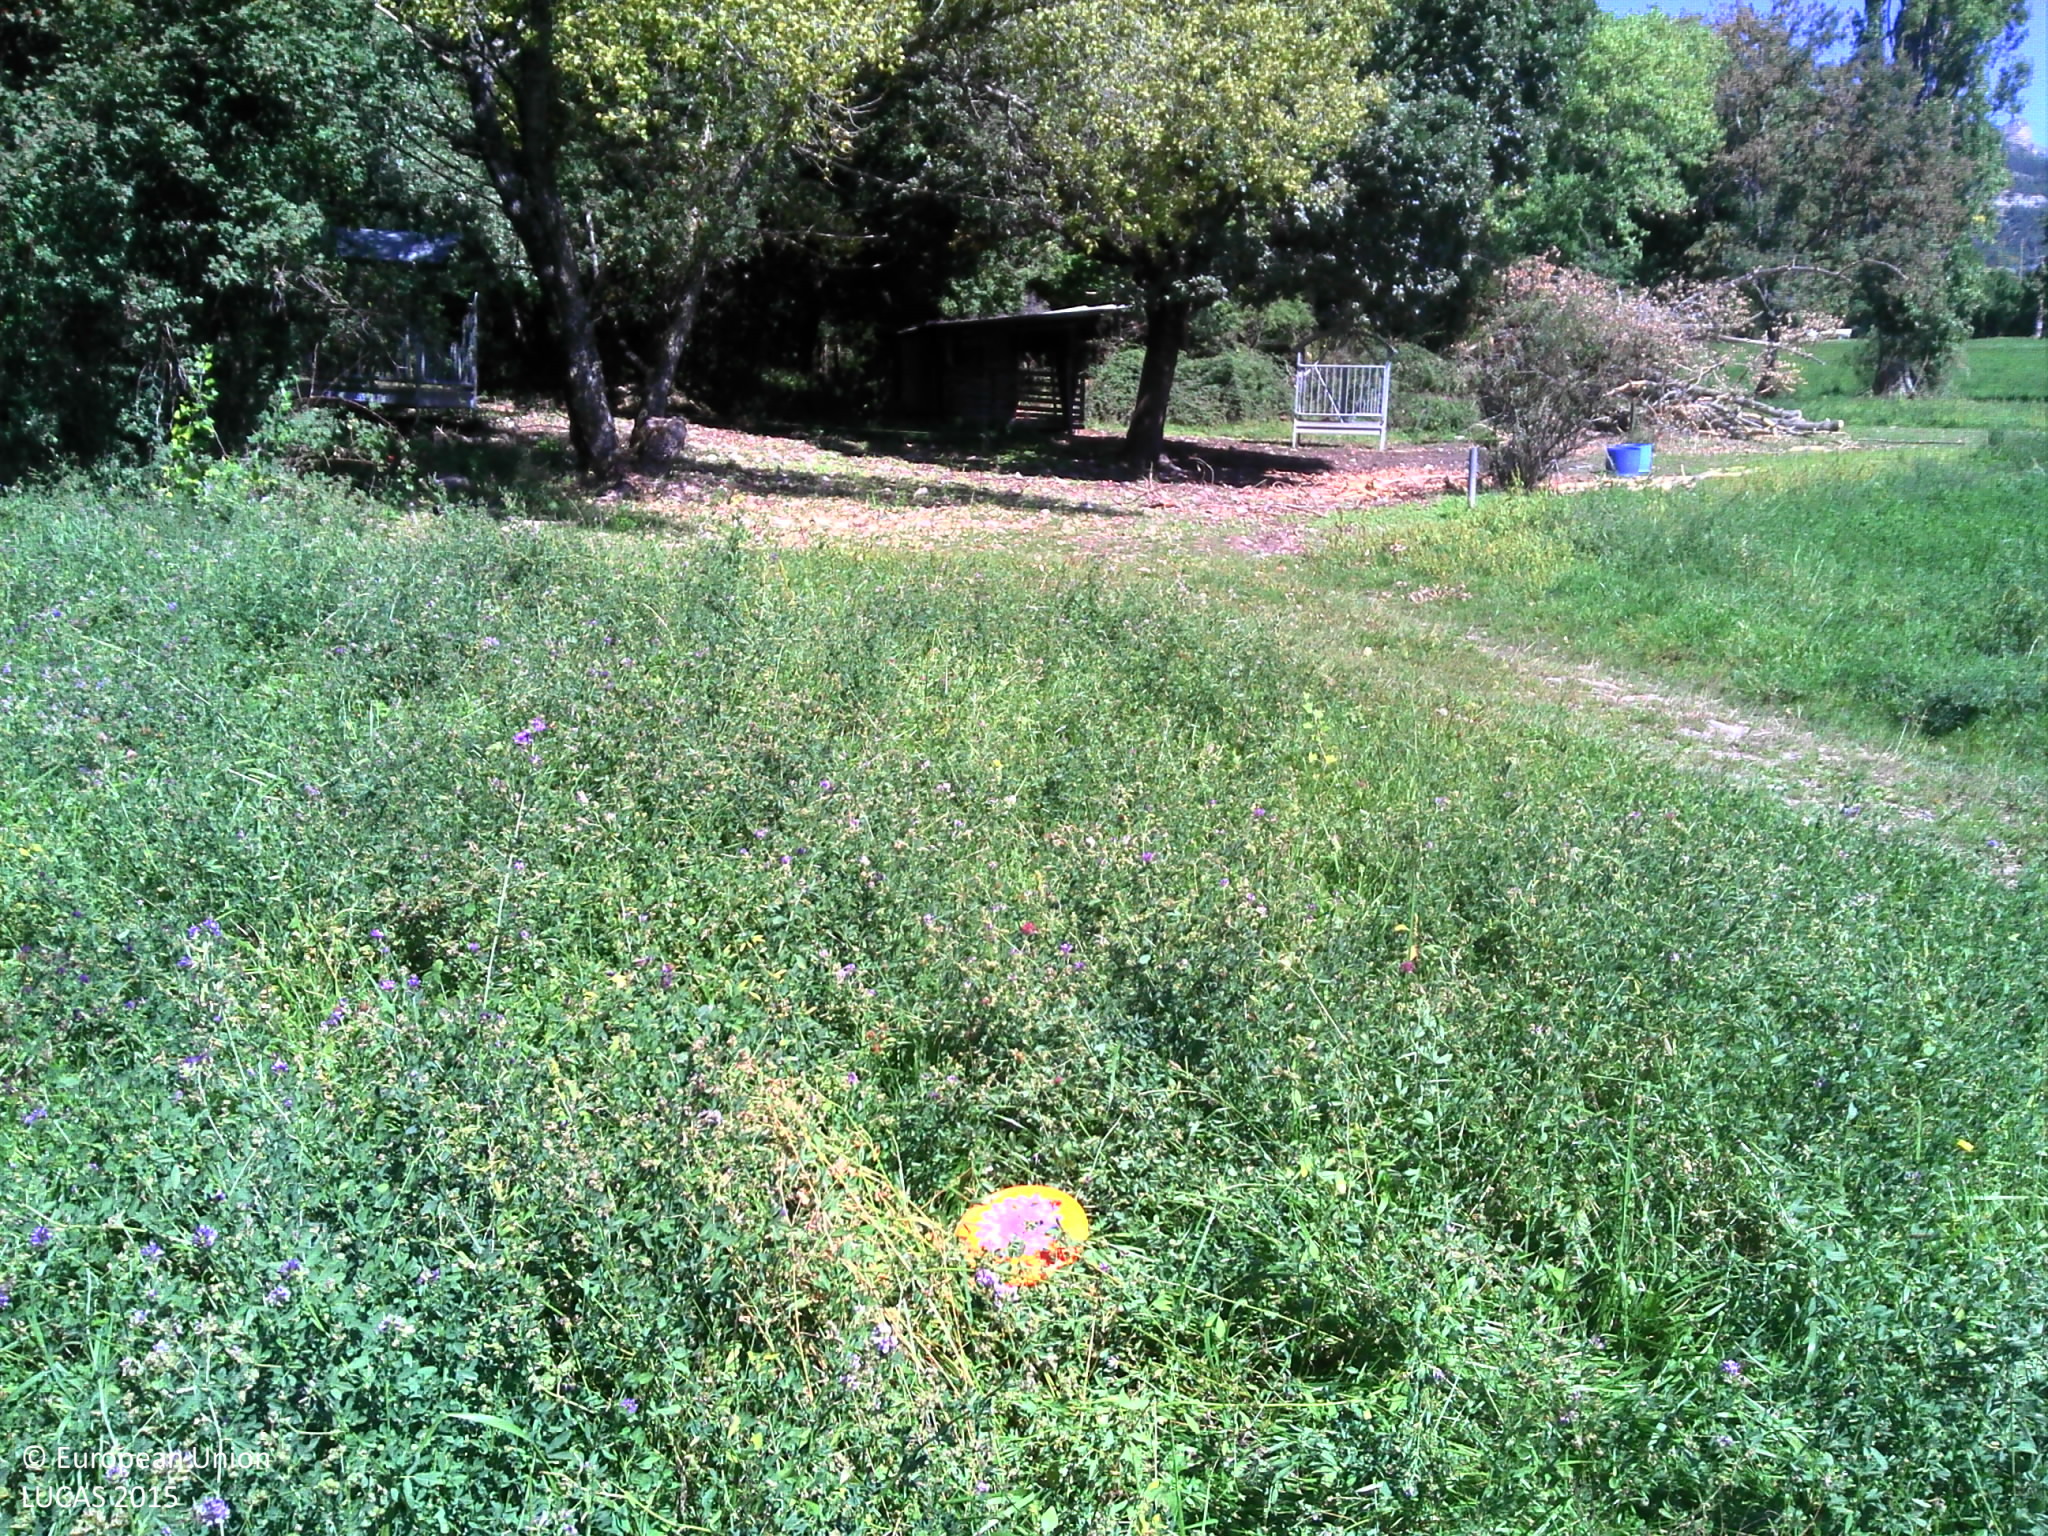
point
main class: Cropland
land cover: Lucerne
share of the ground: > 75 %
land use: Agriculture (excluding fallow land and kitchen gardens)
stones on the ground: < 10 %
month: September
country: FR
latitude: 44.5704
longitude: 6.2163
